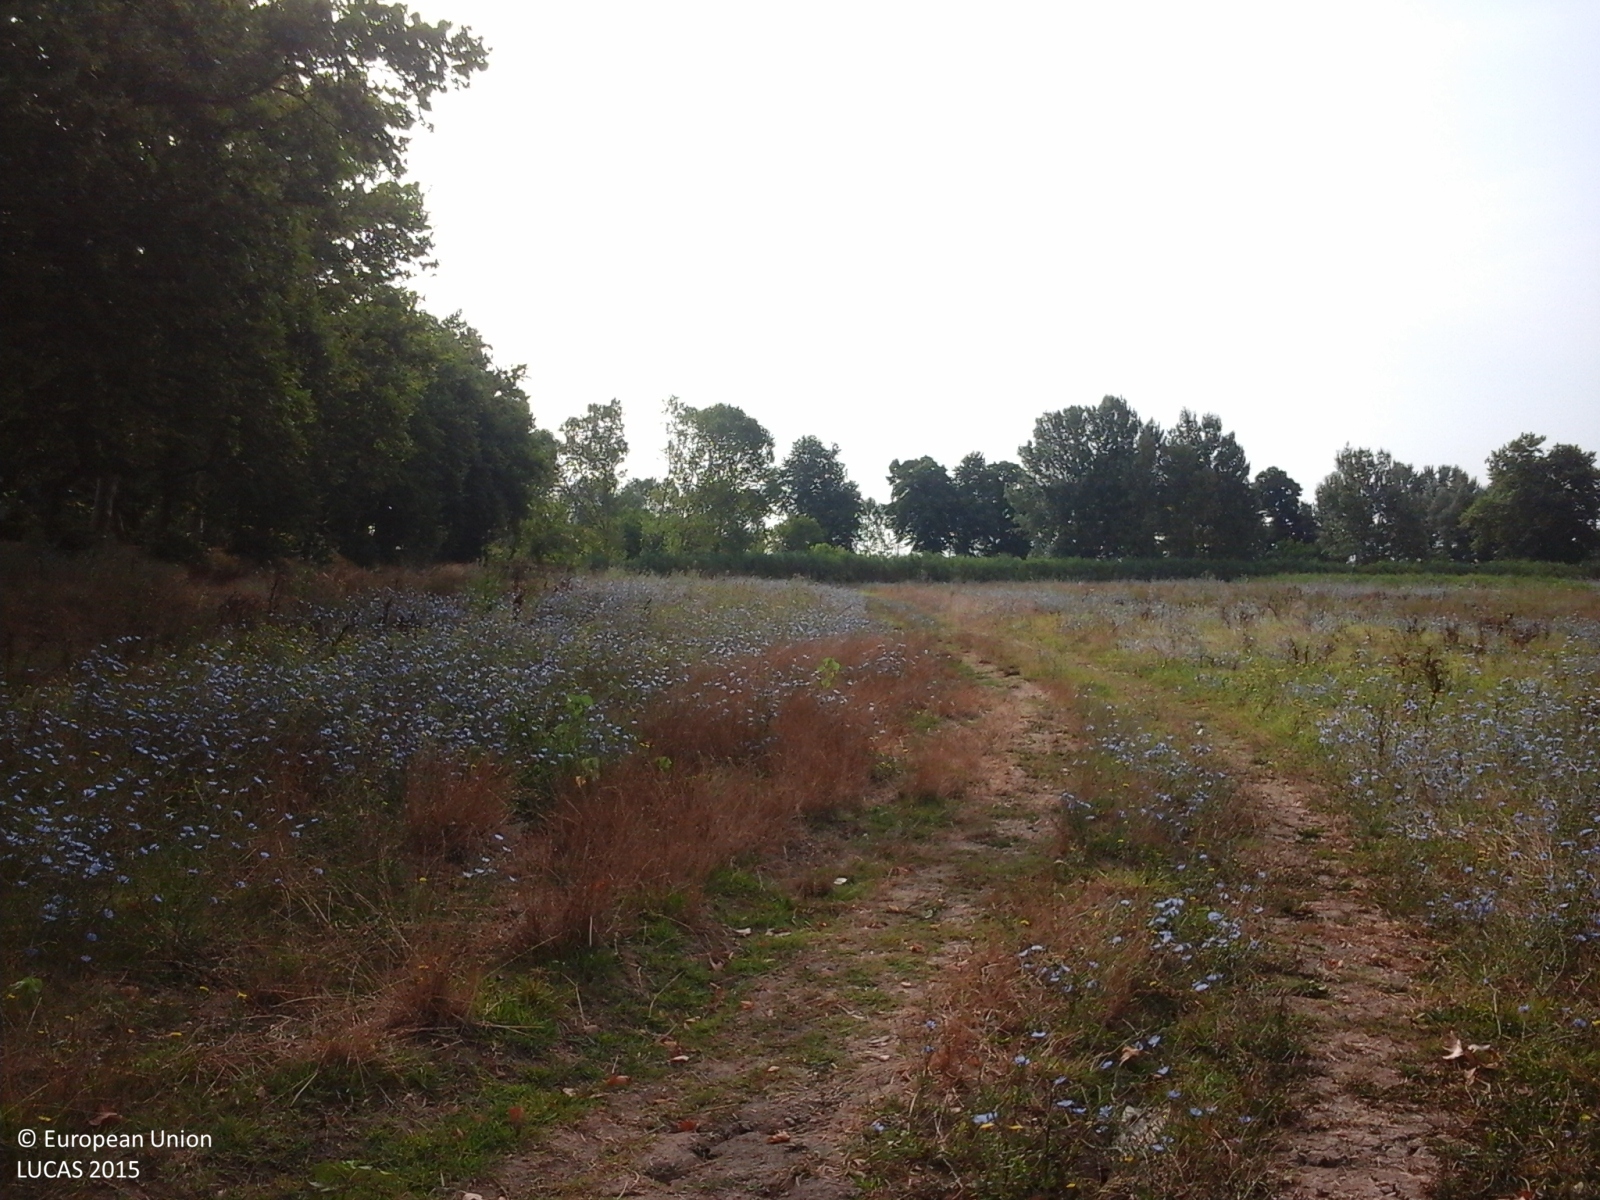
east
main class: Grassland
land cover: Grassland without tree/shrub cover
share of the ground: > 75 %
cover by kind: herbaceous plants 95 %, shrubs 5 %
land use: Agriculture (excluding fallow land and kitchen gardens)
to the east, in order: Grassland without tree/shrub cover; Inland marshes; Grassland without tree/shrub cover; Inland marshes; Tracks; Shruby margins; Ditches and canals; Inland marshes
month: July
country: IT
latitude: 43.7533
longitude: 10.6317
